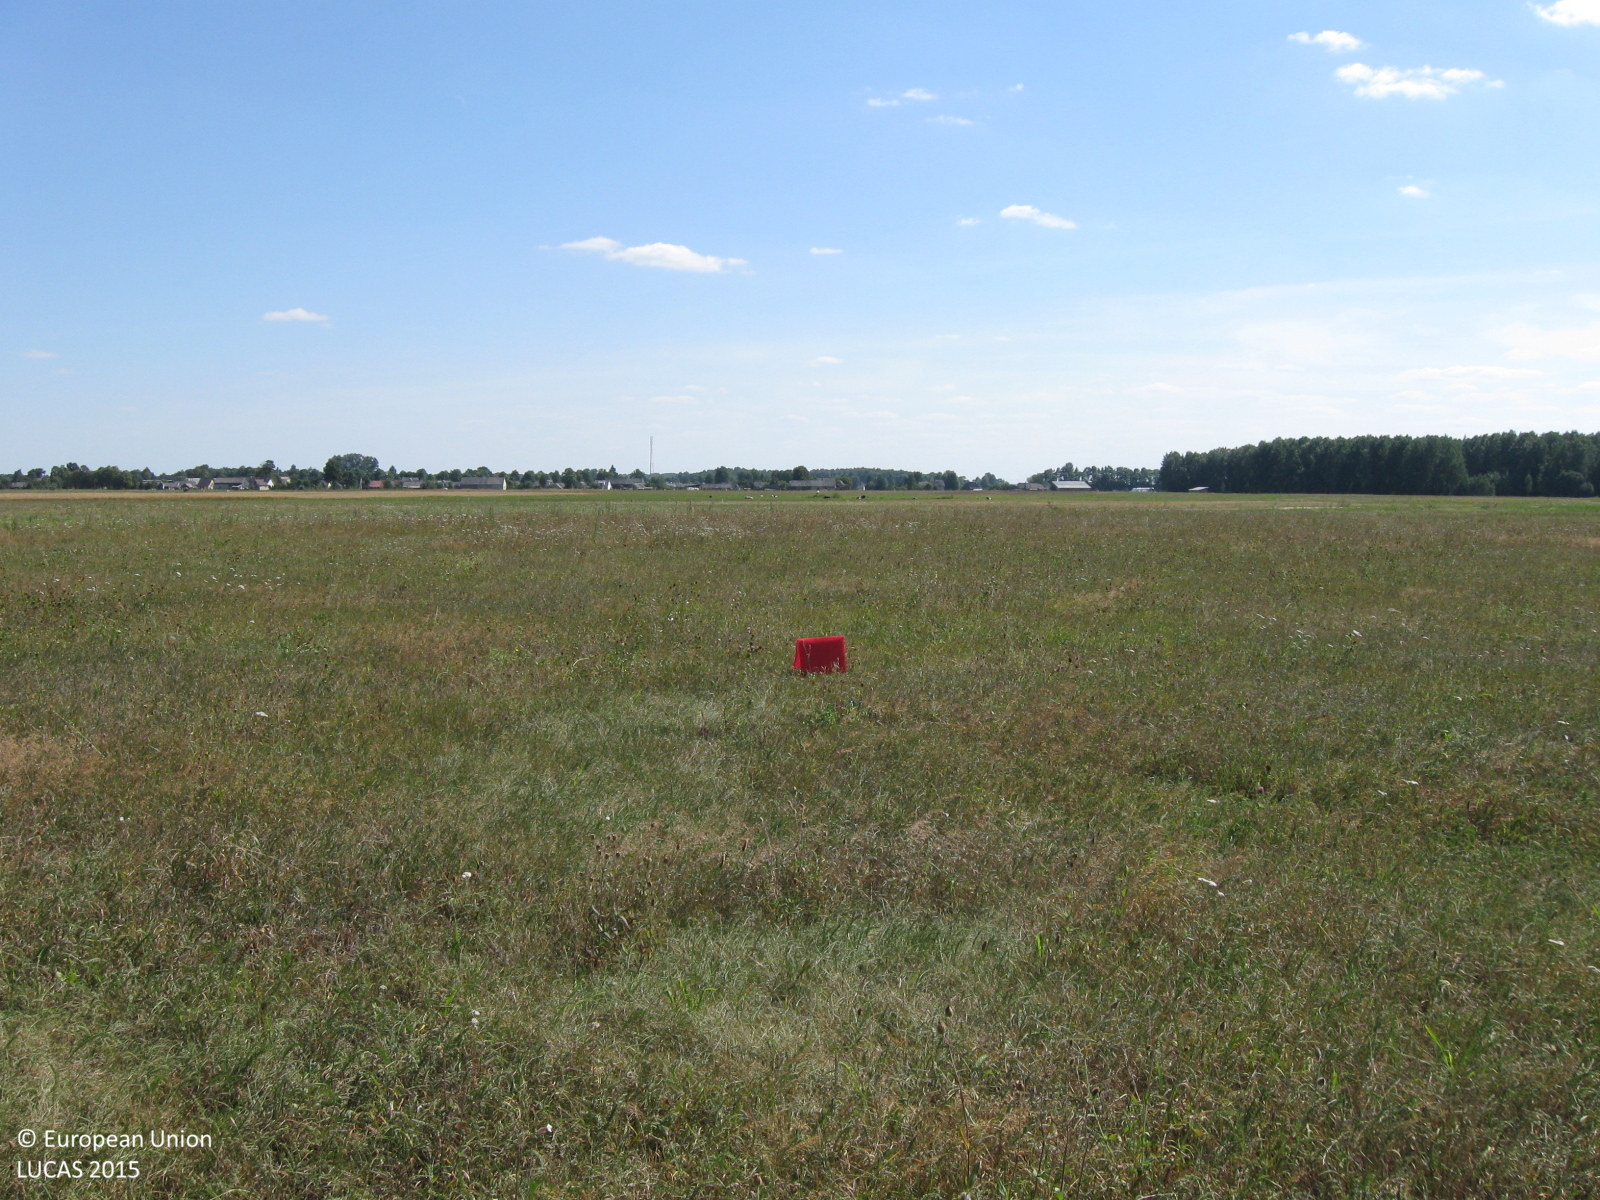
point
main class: Grassland
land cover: Grassland without tree/shrub cover
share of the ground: > 75 %
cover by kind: herbaceous plants 100 %
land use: Agriculture (excluding fallow land and kitchen gardens)
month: August
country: LT
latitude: 55.3367
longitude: 22.5005
